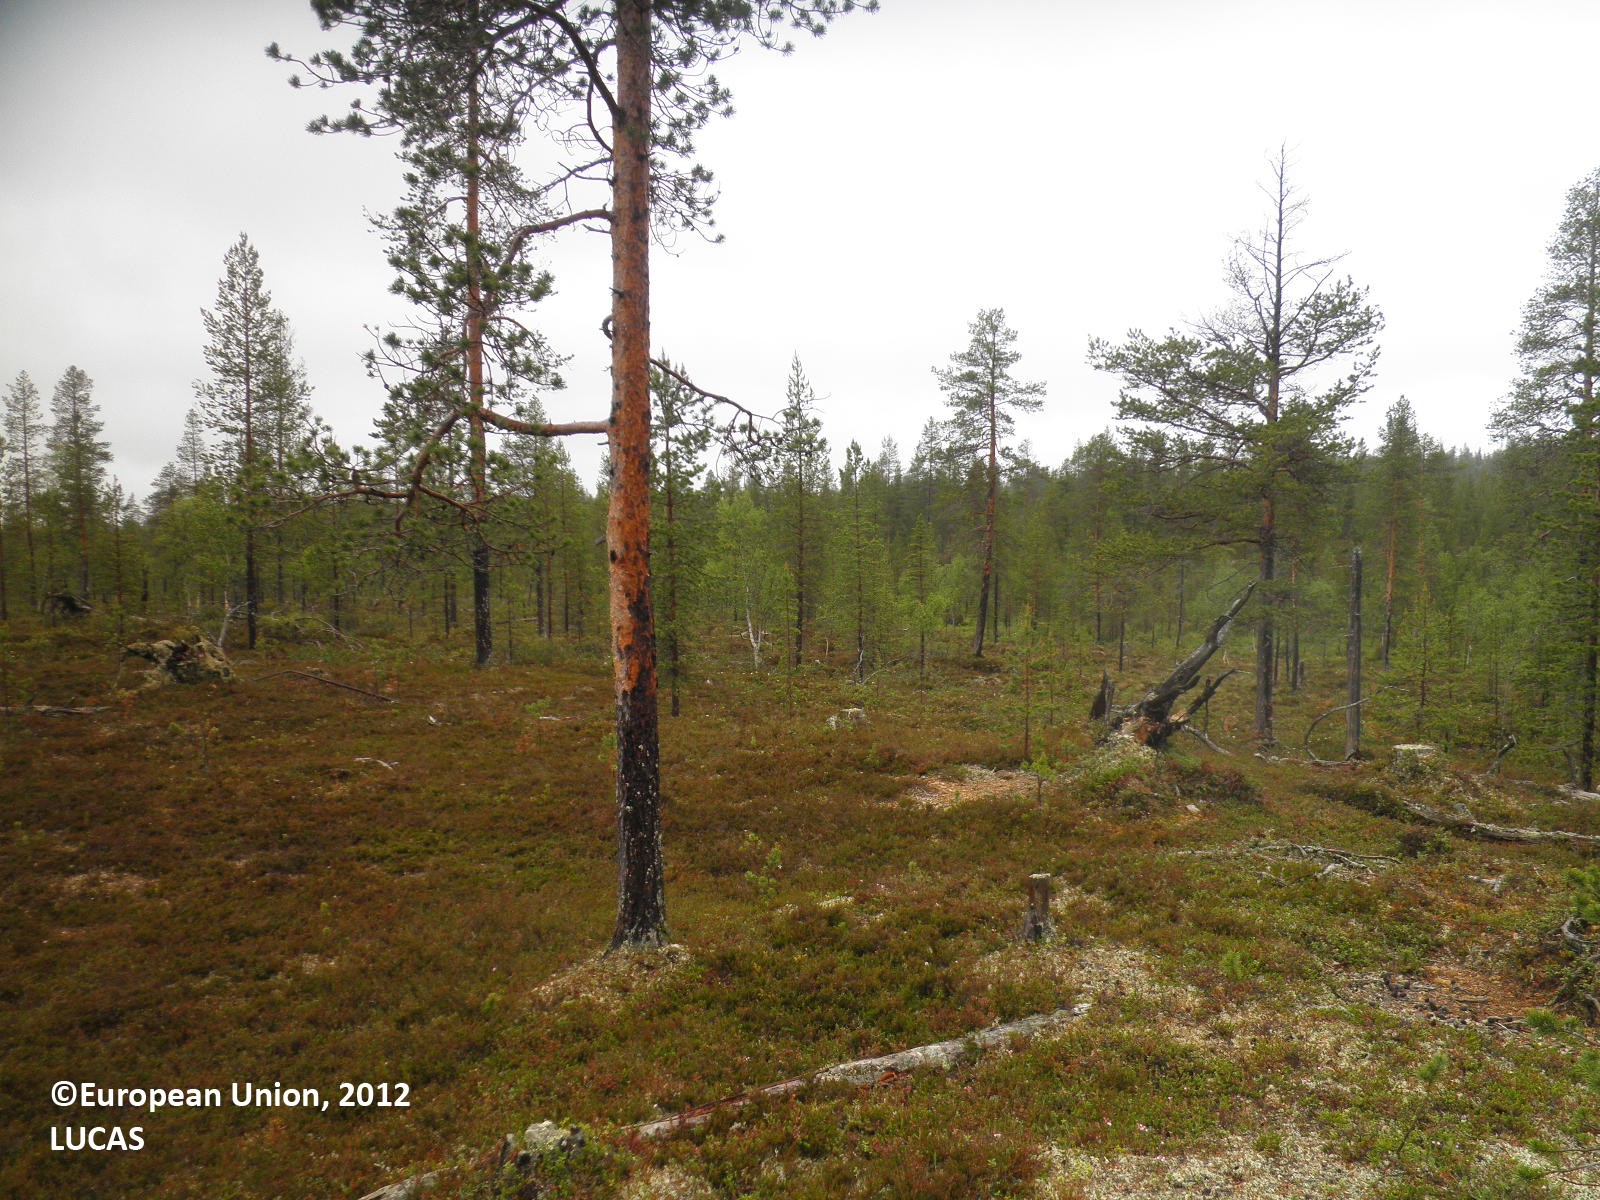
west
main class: Woodland
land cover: Pine dominated coniferous woodland
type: boreal forest
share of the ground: 25 - 50 %
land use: Forestry
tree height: > 5 m
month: June
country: FI
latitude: 68.4806
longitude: 27.5982
